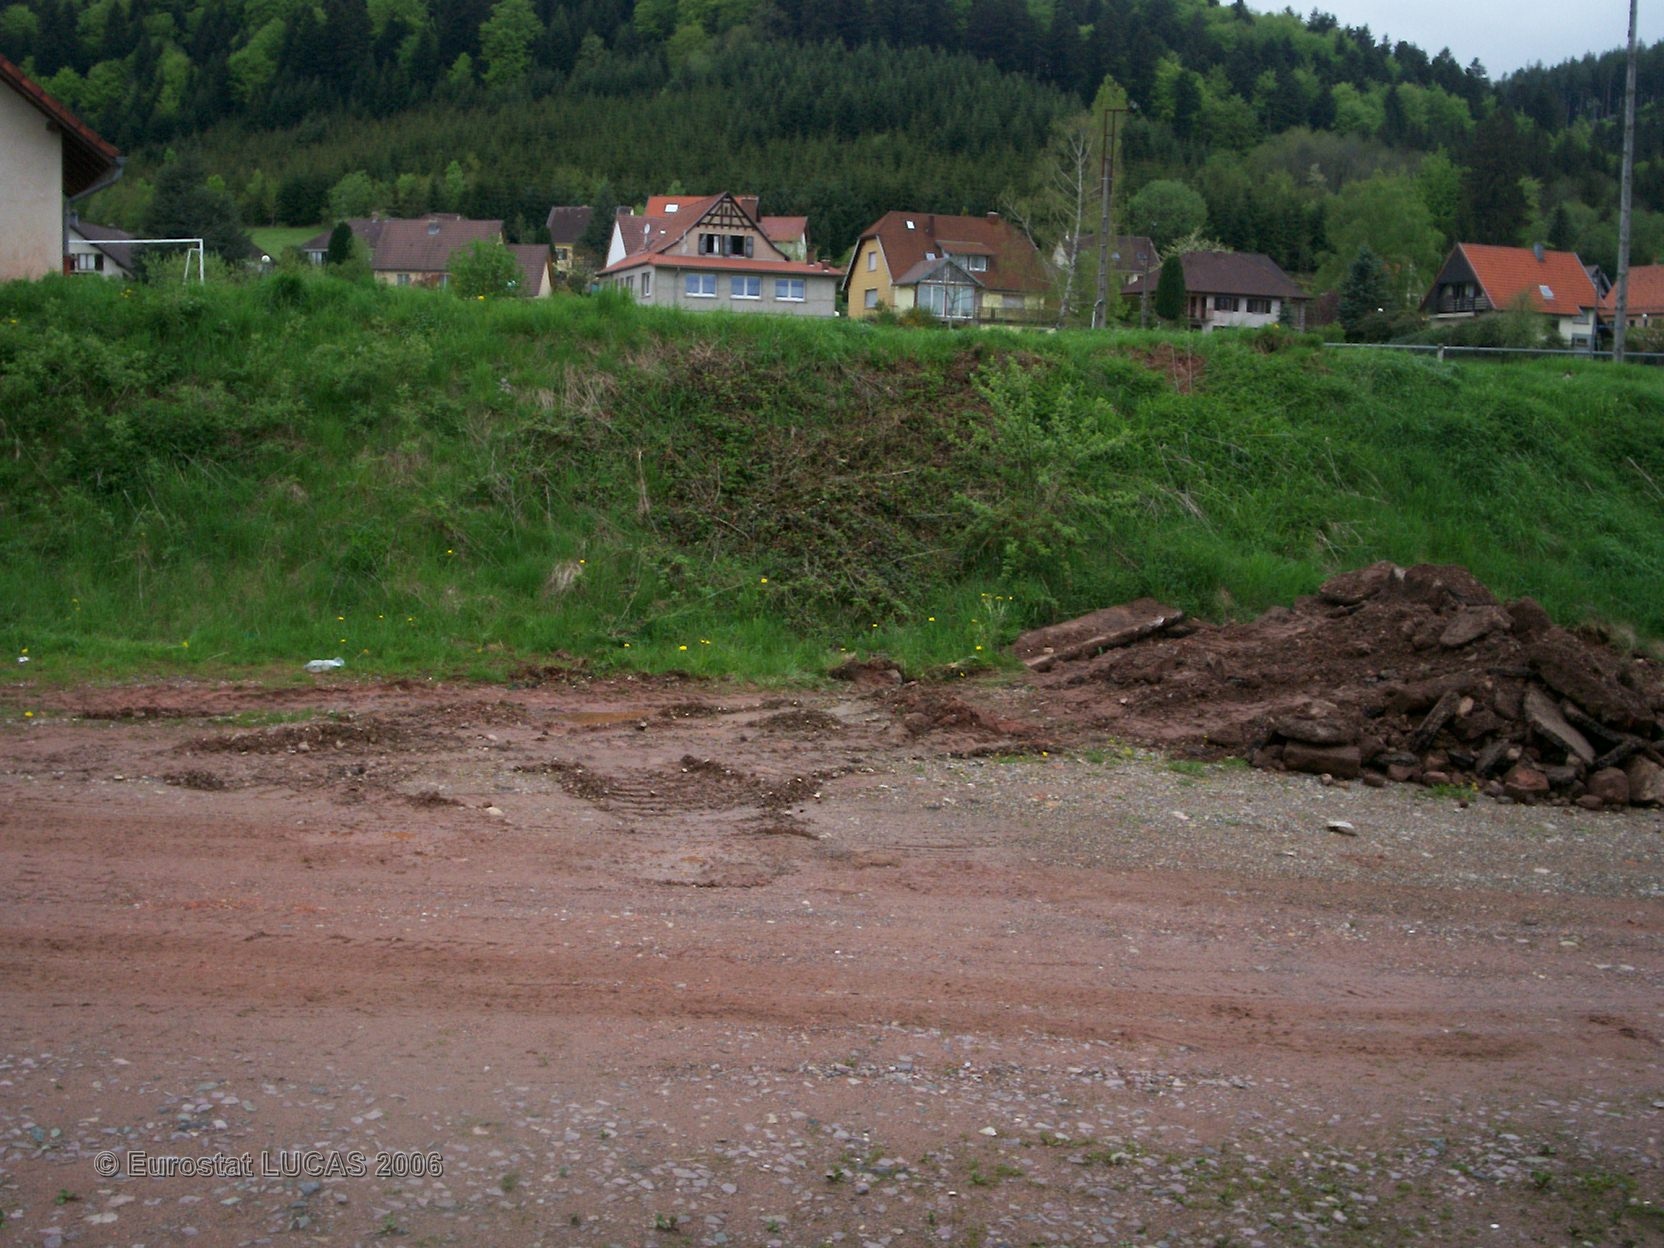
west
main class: Grassland
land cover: Grassland with sparse tree/shrub cover
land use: Amenities, museums, leisure
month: May
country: FR
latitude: 48.3475
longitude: 7.0998
